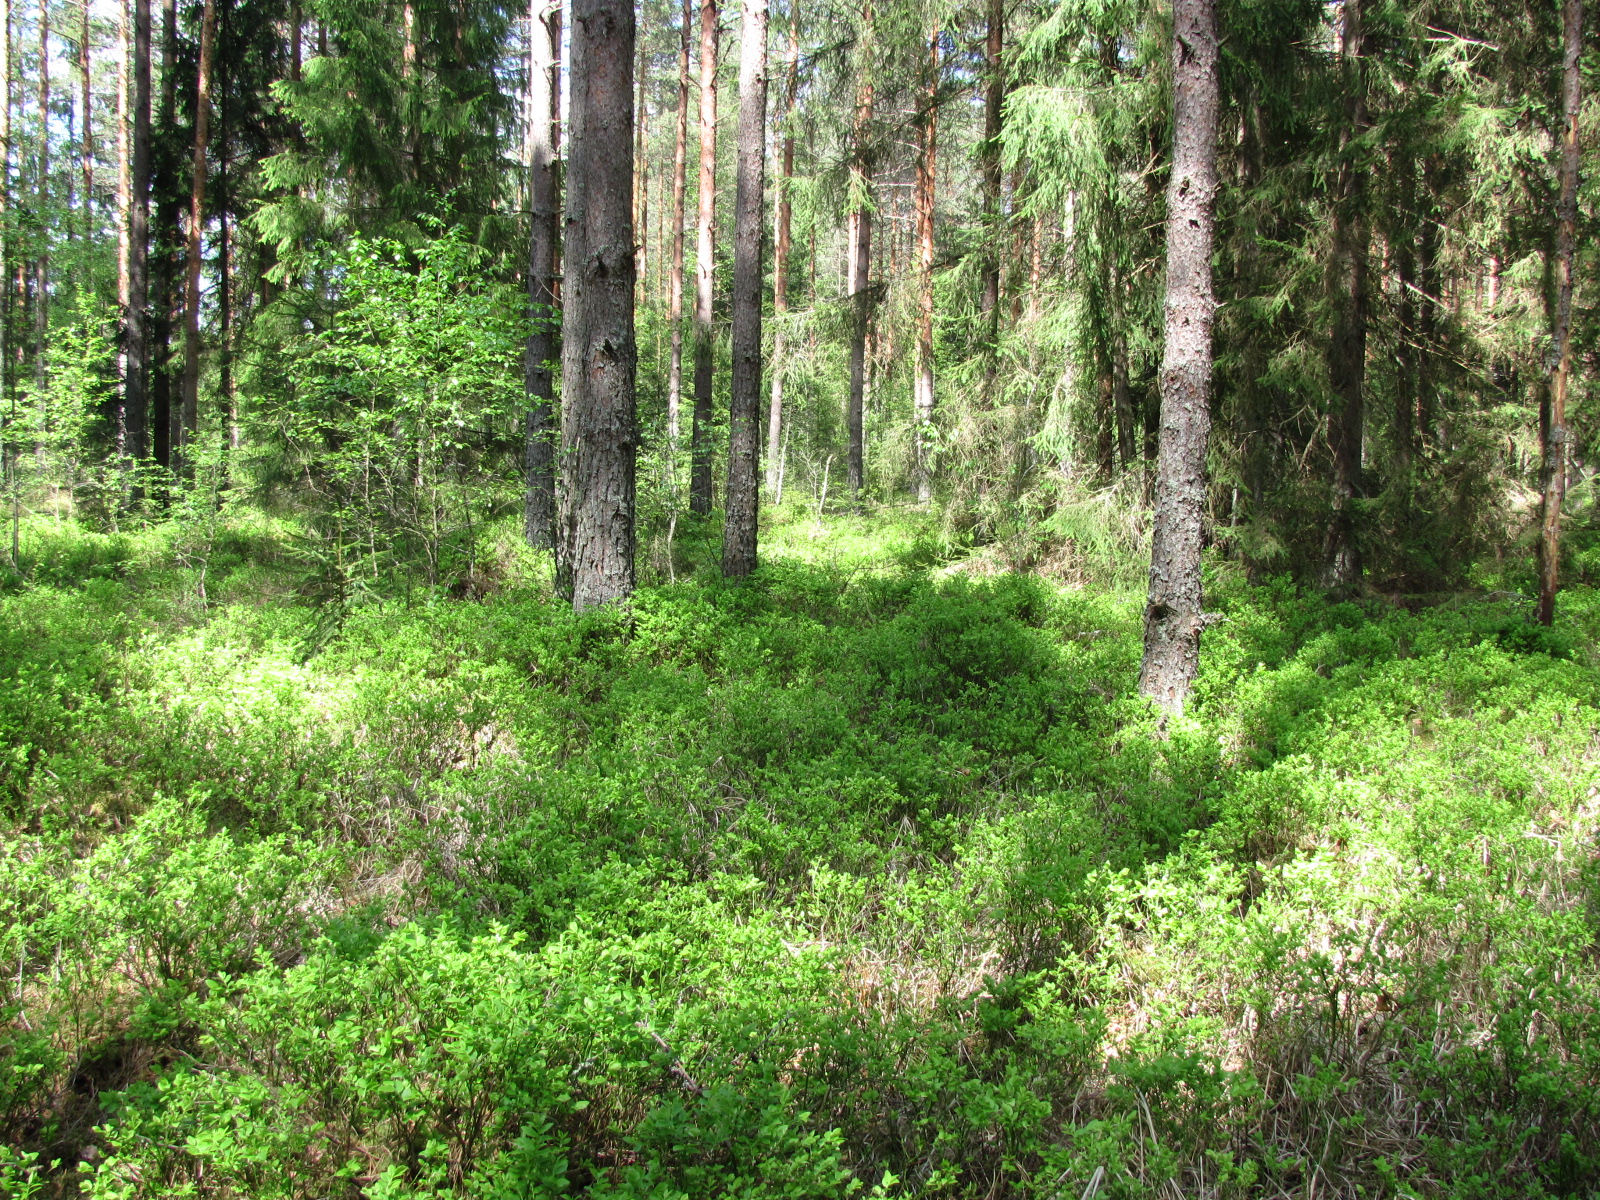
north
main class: Woodland
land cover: Other coniferous woodland
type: hemiboreal forest and nemoral coniferous forest and mixed broadleaved-coniferous forest
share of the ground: > 75 %
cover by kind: coniferous forest trees 85 %, herbaceous plants 15 %
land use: Forestry
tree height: > 5 m
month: May
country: LV
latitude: 56.7491
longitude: 24.5017
